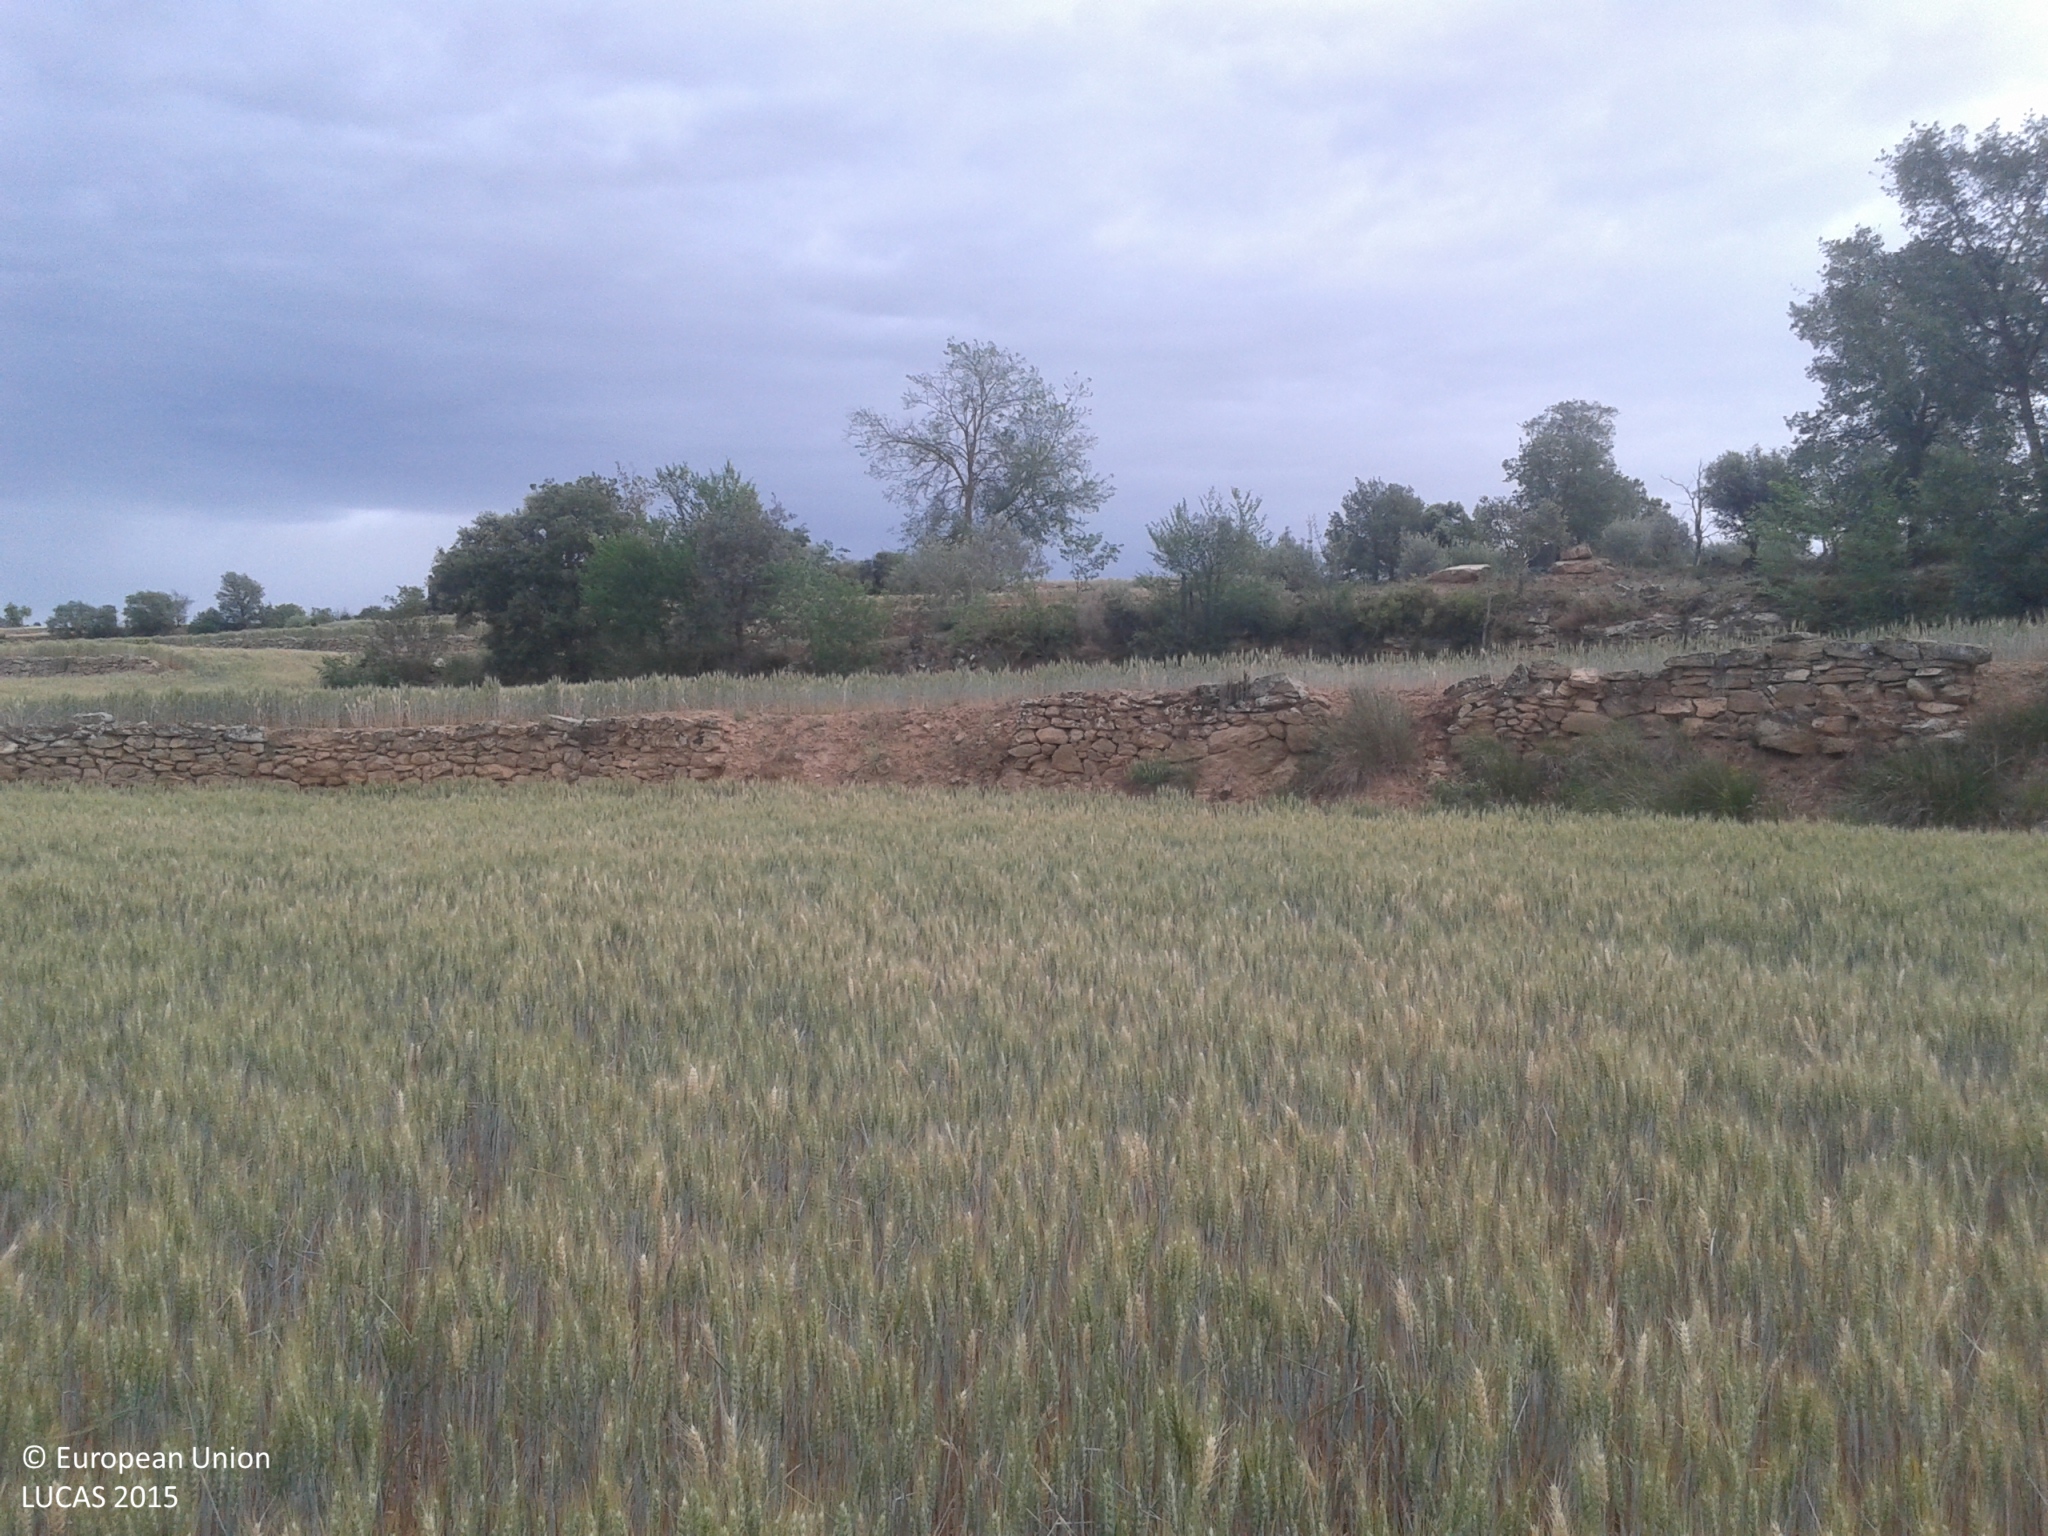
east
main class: Cropland
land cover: Common wheat
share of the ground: > 75 %
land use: Agriculture (excluding fallow land and kitchen gardens)
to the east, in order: Common wheat; Grass margins; Dry stone walls; Common wheat; Groves; Dry stone walls; Grassland with sparse tree/shrub cover; Common wheat; Dry stone walls; Shruby margins; Common wheat; Shruby margins; Dry stone walls; Common wheat; Grass margins; Tracks; Barley
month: May
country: ES
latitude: 41.8965
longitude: 1.0801
